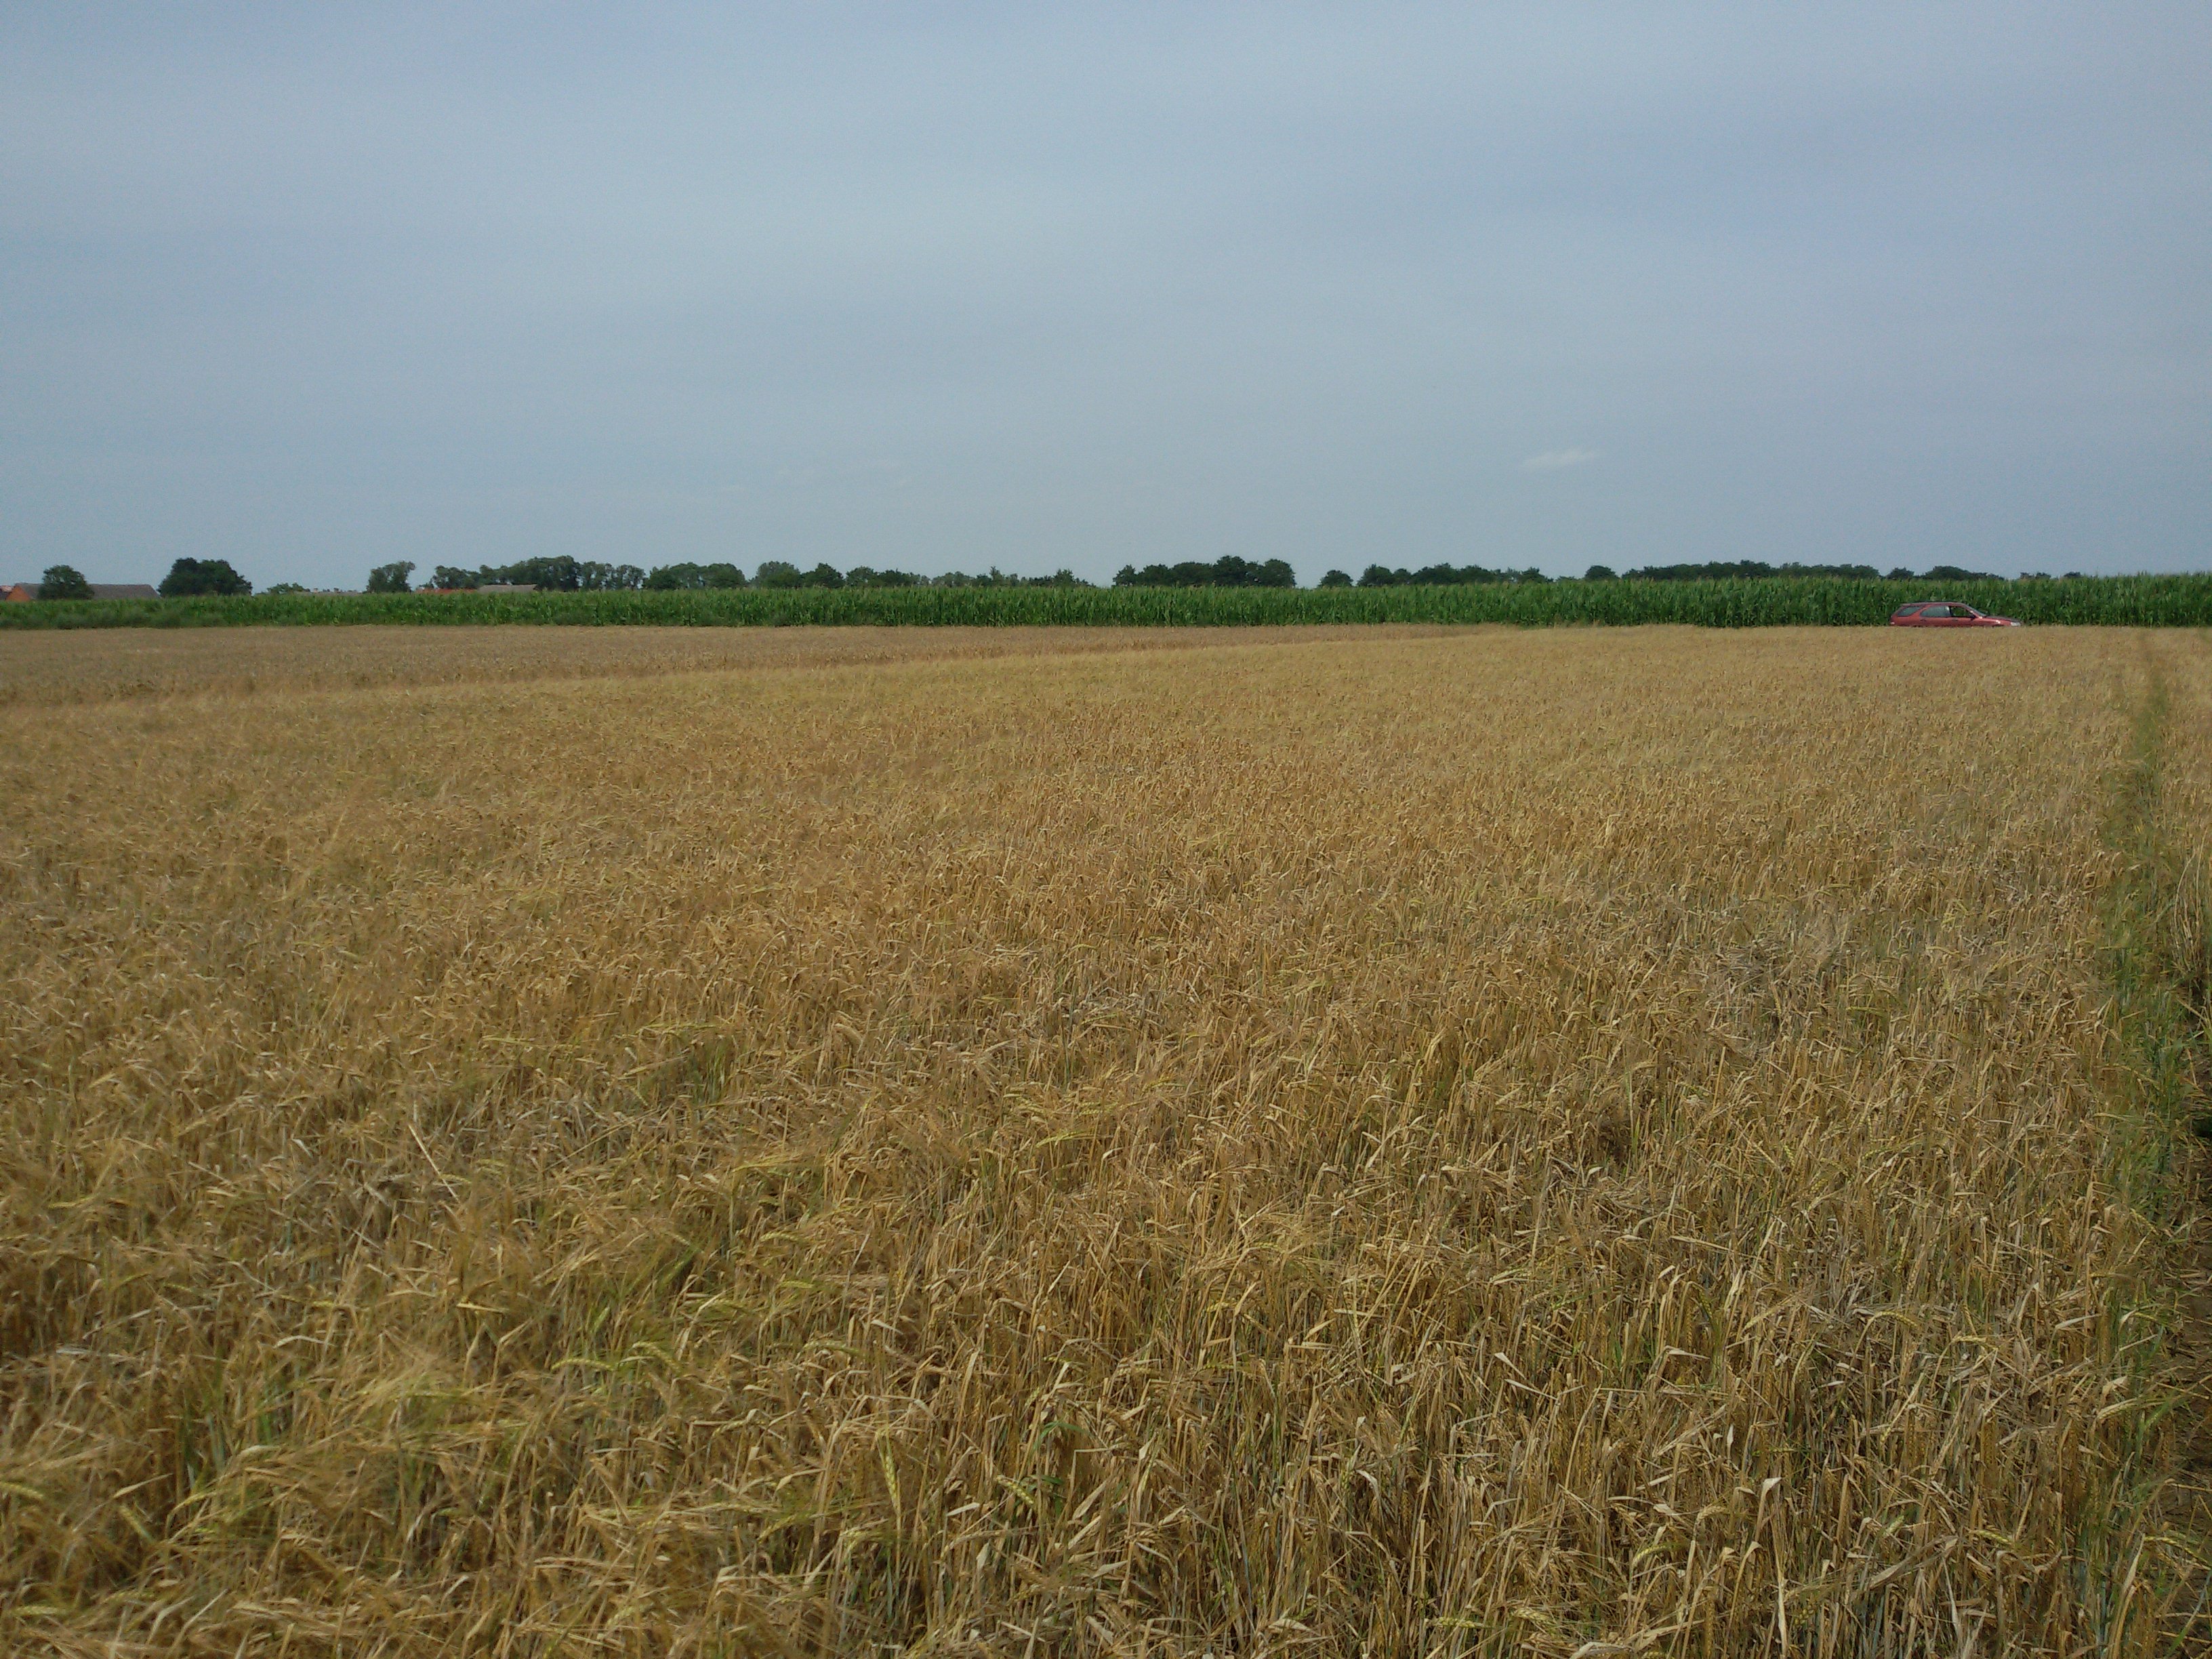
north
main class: Cropland
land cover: Barley
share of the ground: > 75 %
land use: Agriculture (excluding fallow land and kitchen gardens)
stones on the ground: < 10 %
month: July
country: PL
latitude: 52.4451
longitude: 17.5307
